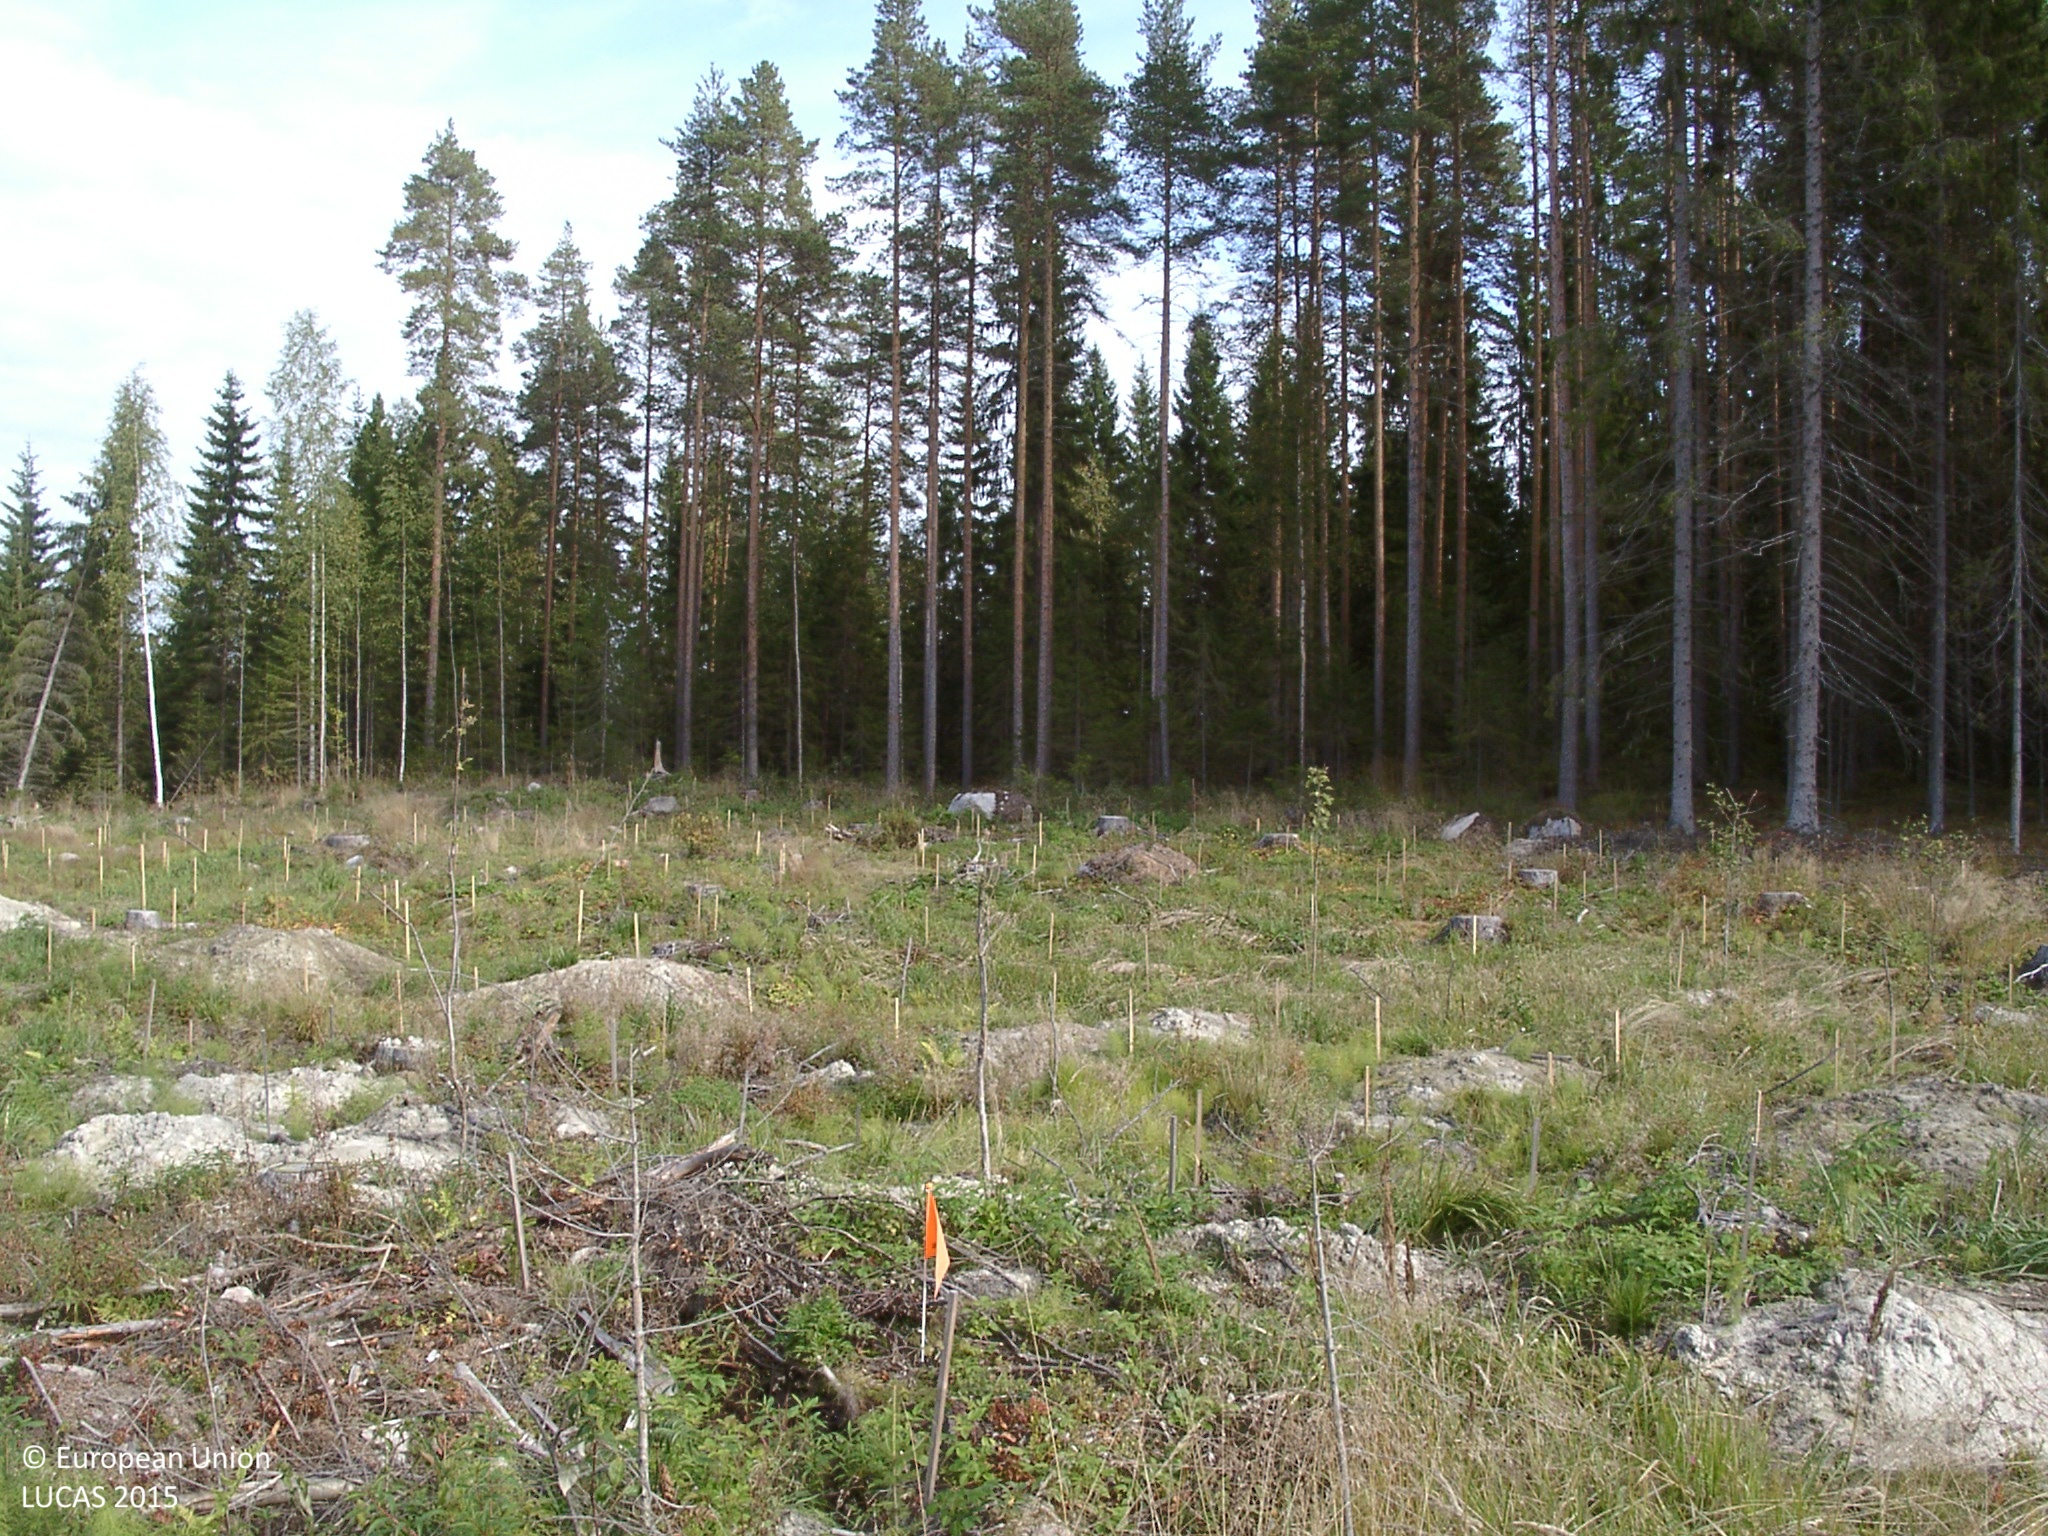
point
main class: Shrubland
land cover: Shrubland without tree cover
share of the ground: 10 - 25 %
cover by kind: herbaceous plants 65 %, unconsolidated bare surface 20 %, shrubs 10 %
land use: Forestry
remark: Clear cut
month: September
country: FI
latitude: 62.5446
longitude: 25.8082
